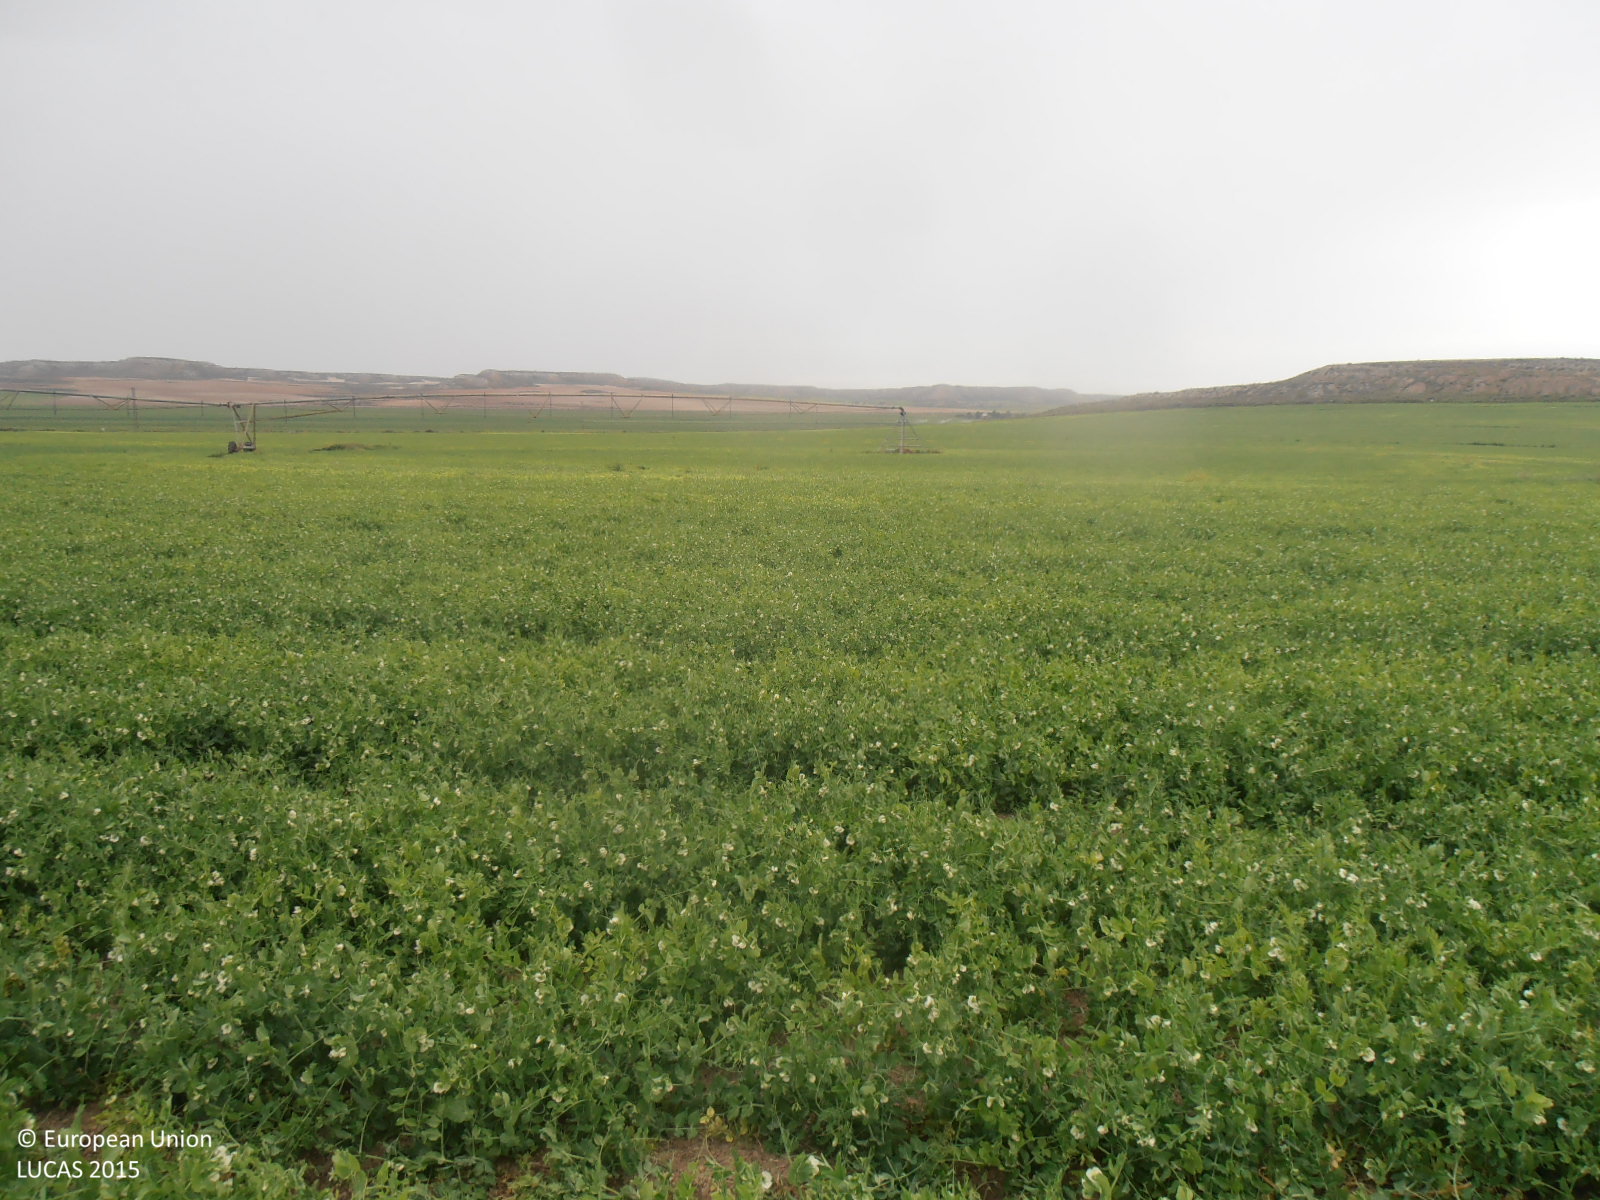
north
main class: Cropland
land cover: Dry pulses
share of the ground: > 75 %
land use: Agriculture (excluding fallow land and kitchen gardens)
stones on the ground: < 10 %
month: April
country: ES
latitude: 41.4445
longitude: -0.3938
